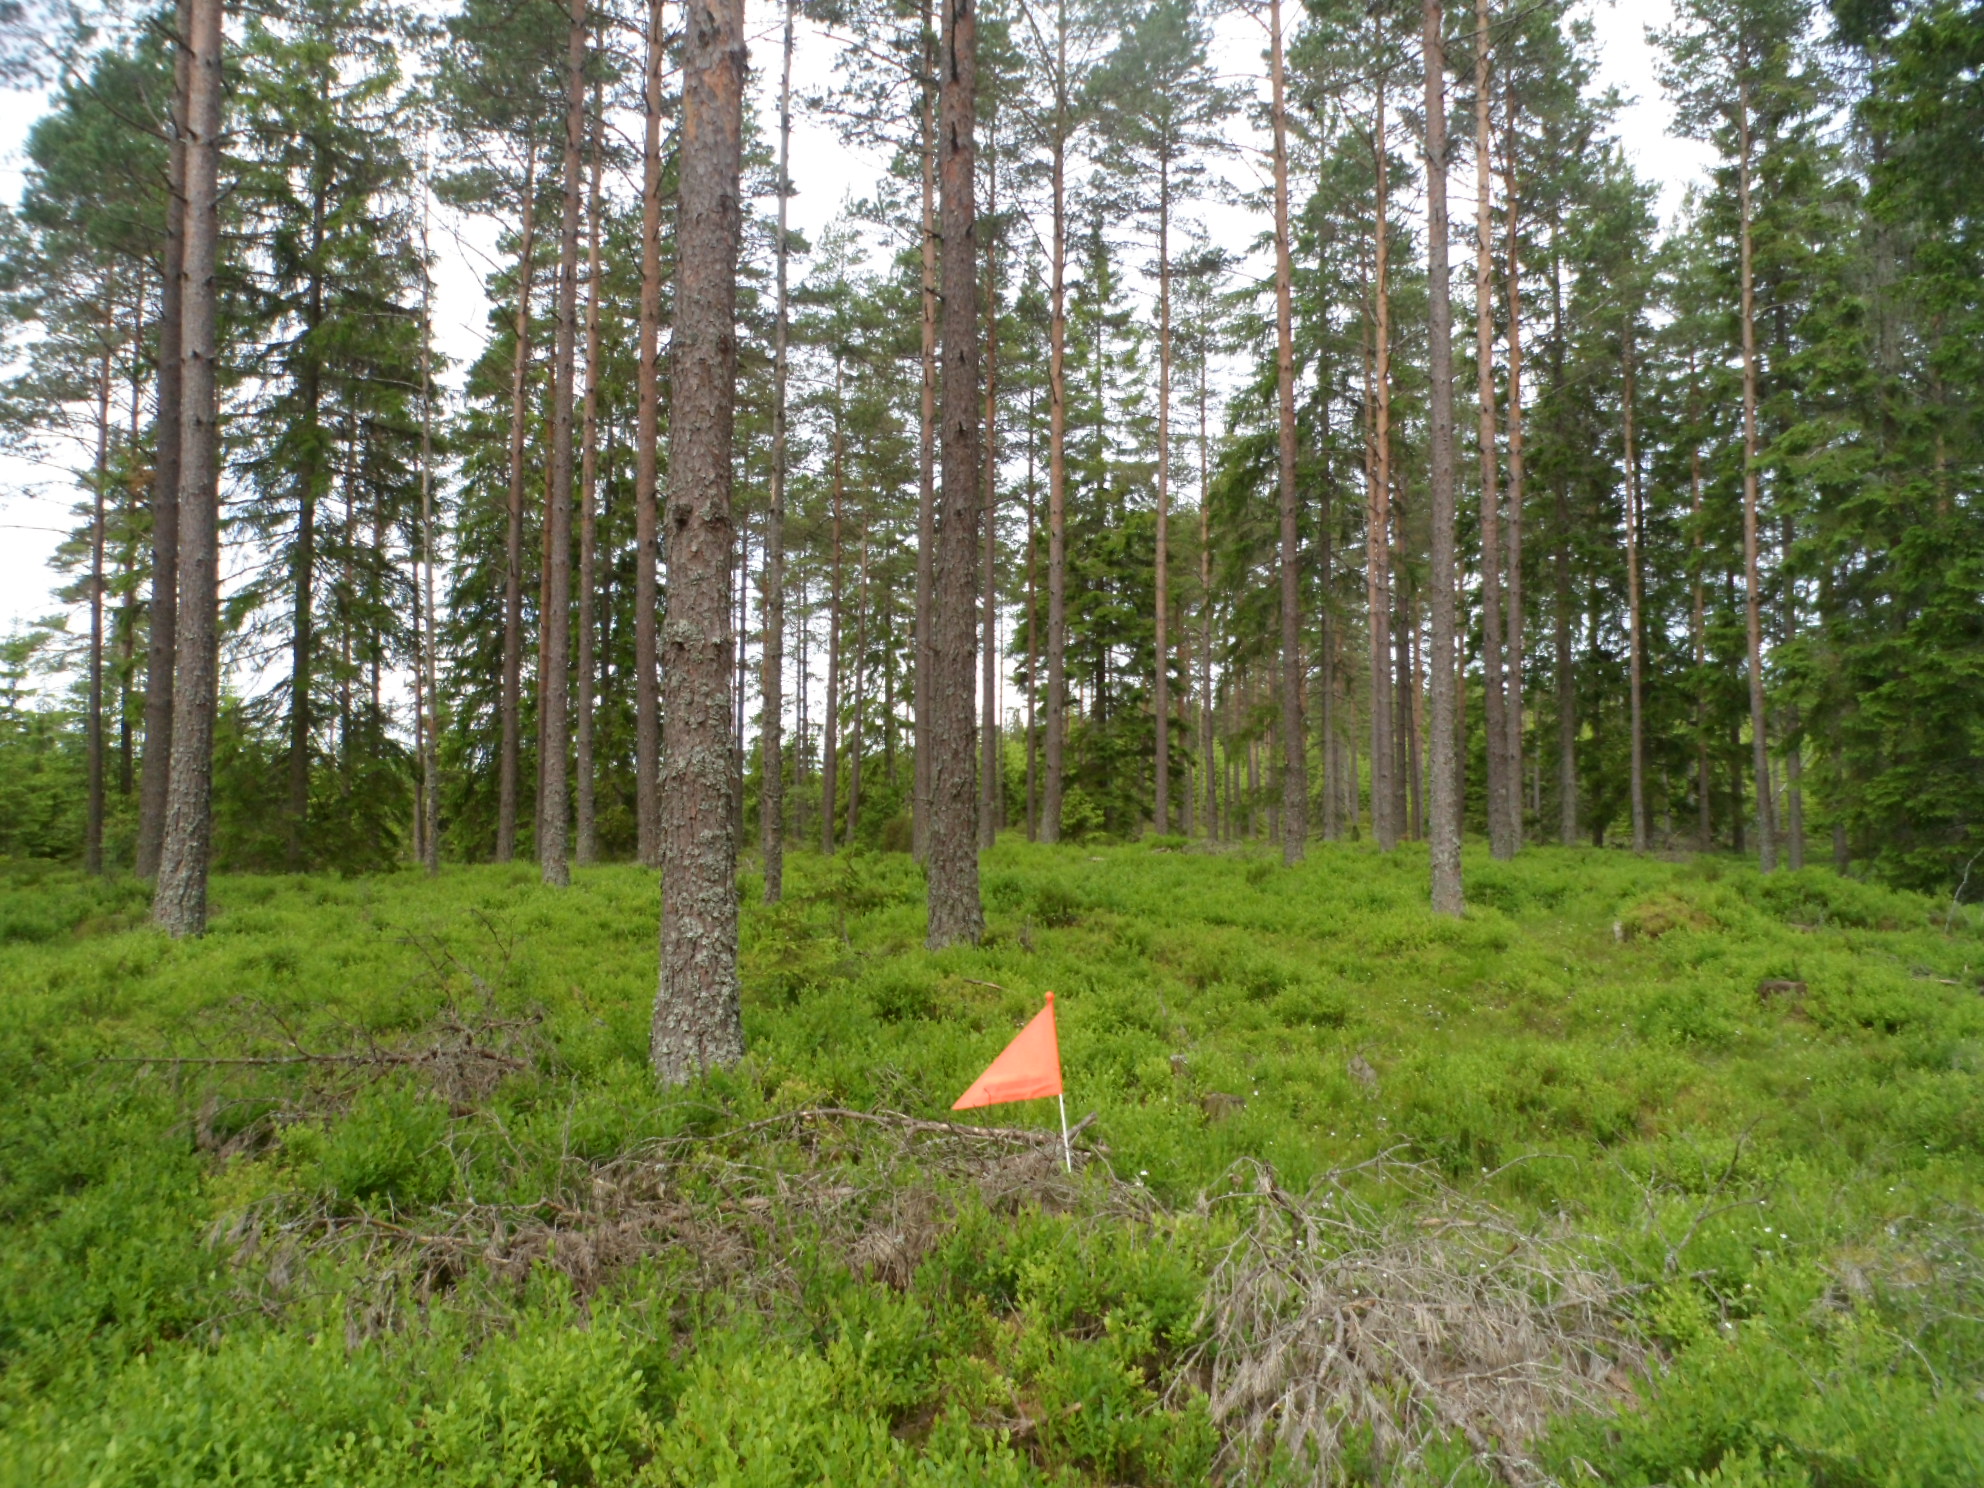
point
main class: Woodland
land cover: Pine dominated coniferous woodland
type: boreal forest
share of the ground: 50 - 75 %
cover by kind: coniferous forest trees 50 %, shrubs 30 %, lichens and mosses 15 %, herbaceous plants 5 %
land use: Forestry
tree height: > 5 m
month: June
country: SE
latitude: 57.0353
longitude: 15.2540
